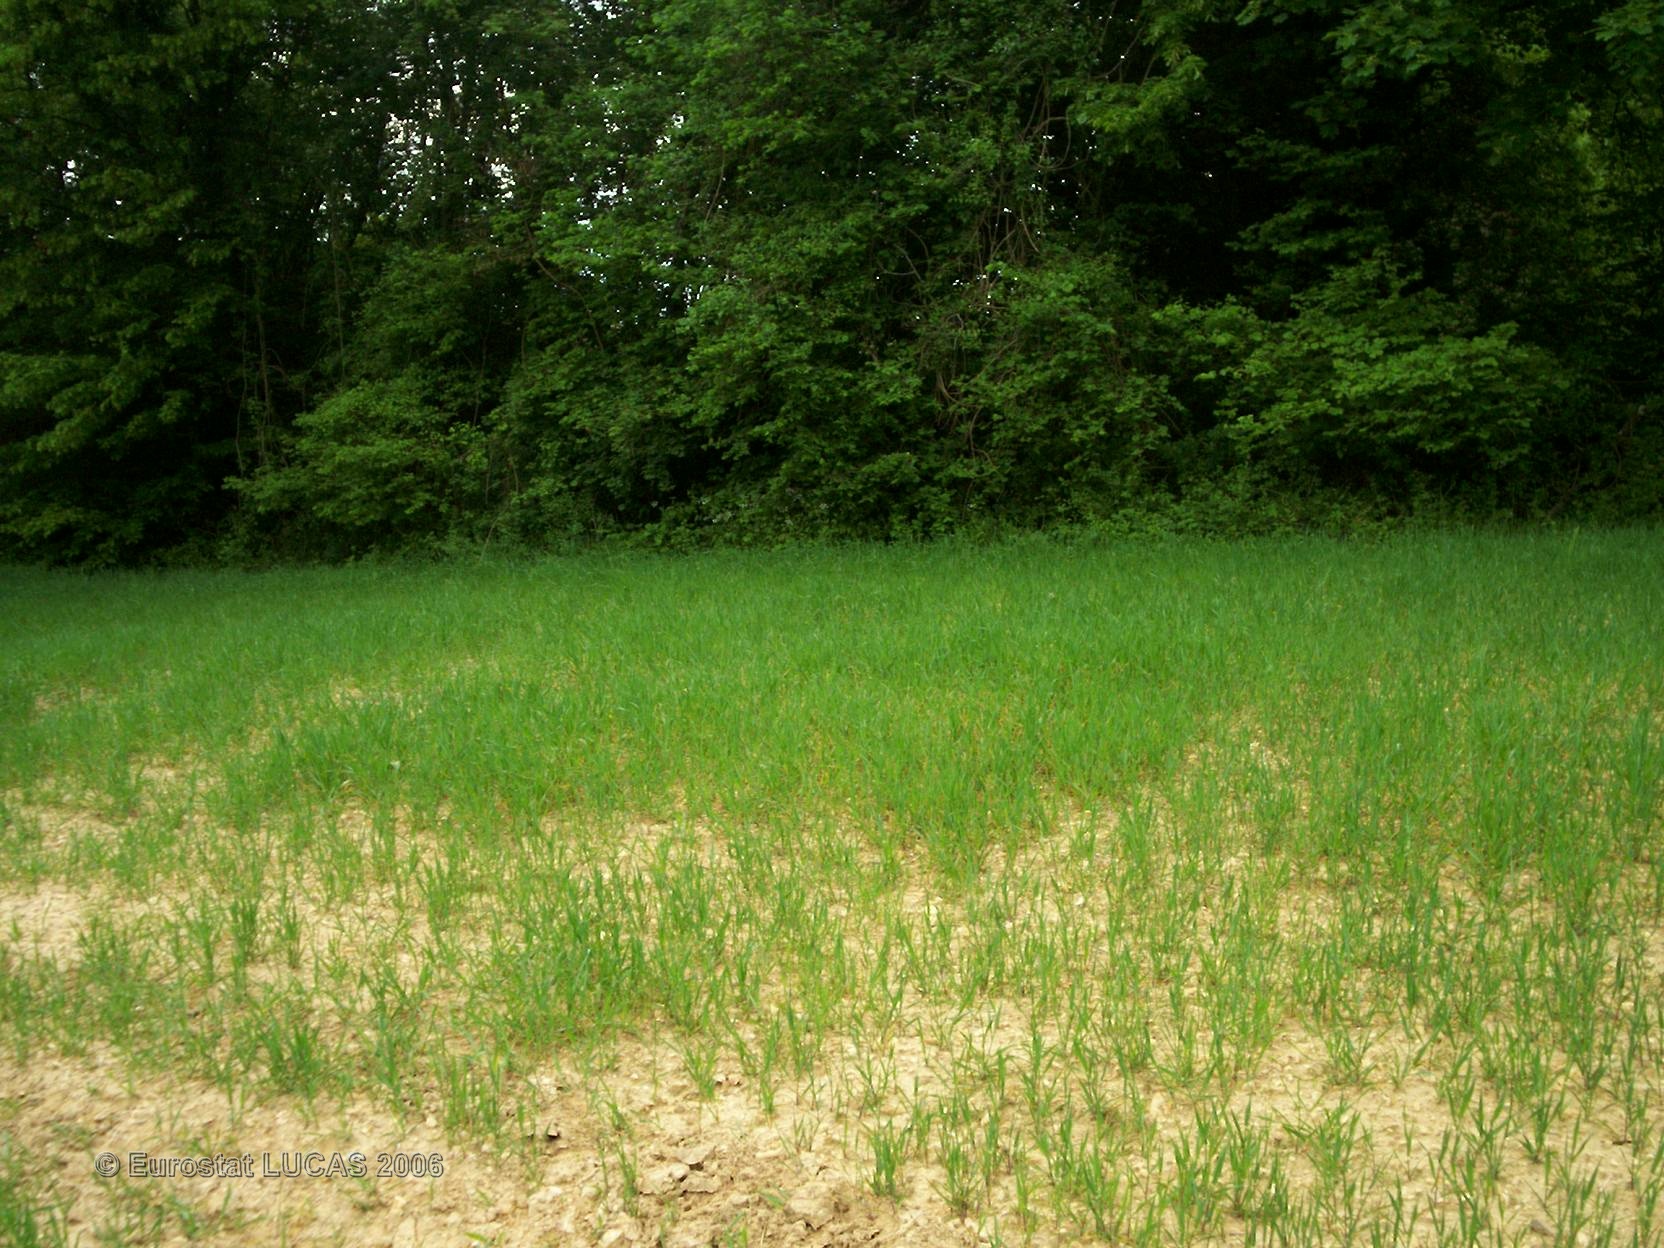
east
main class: Cropland
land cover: Barley
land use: Agriculture (excluding fallow land and kitchen gardens)
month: May
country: FR
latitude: 46.9124
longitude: 0.9908
